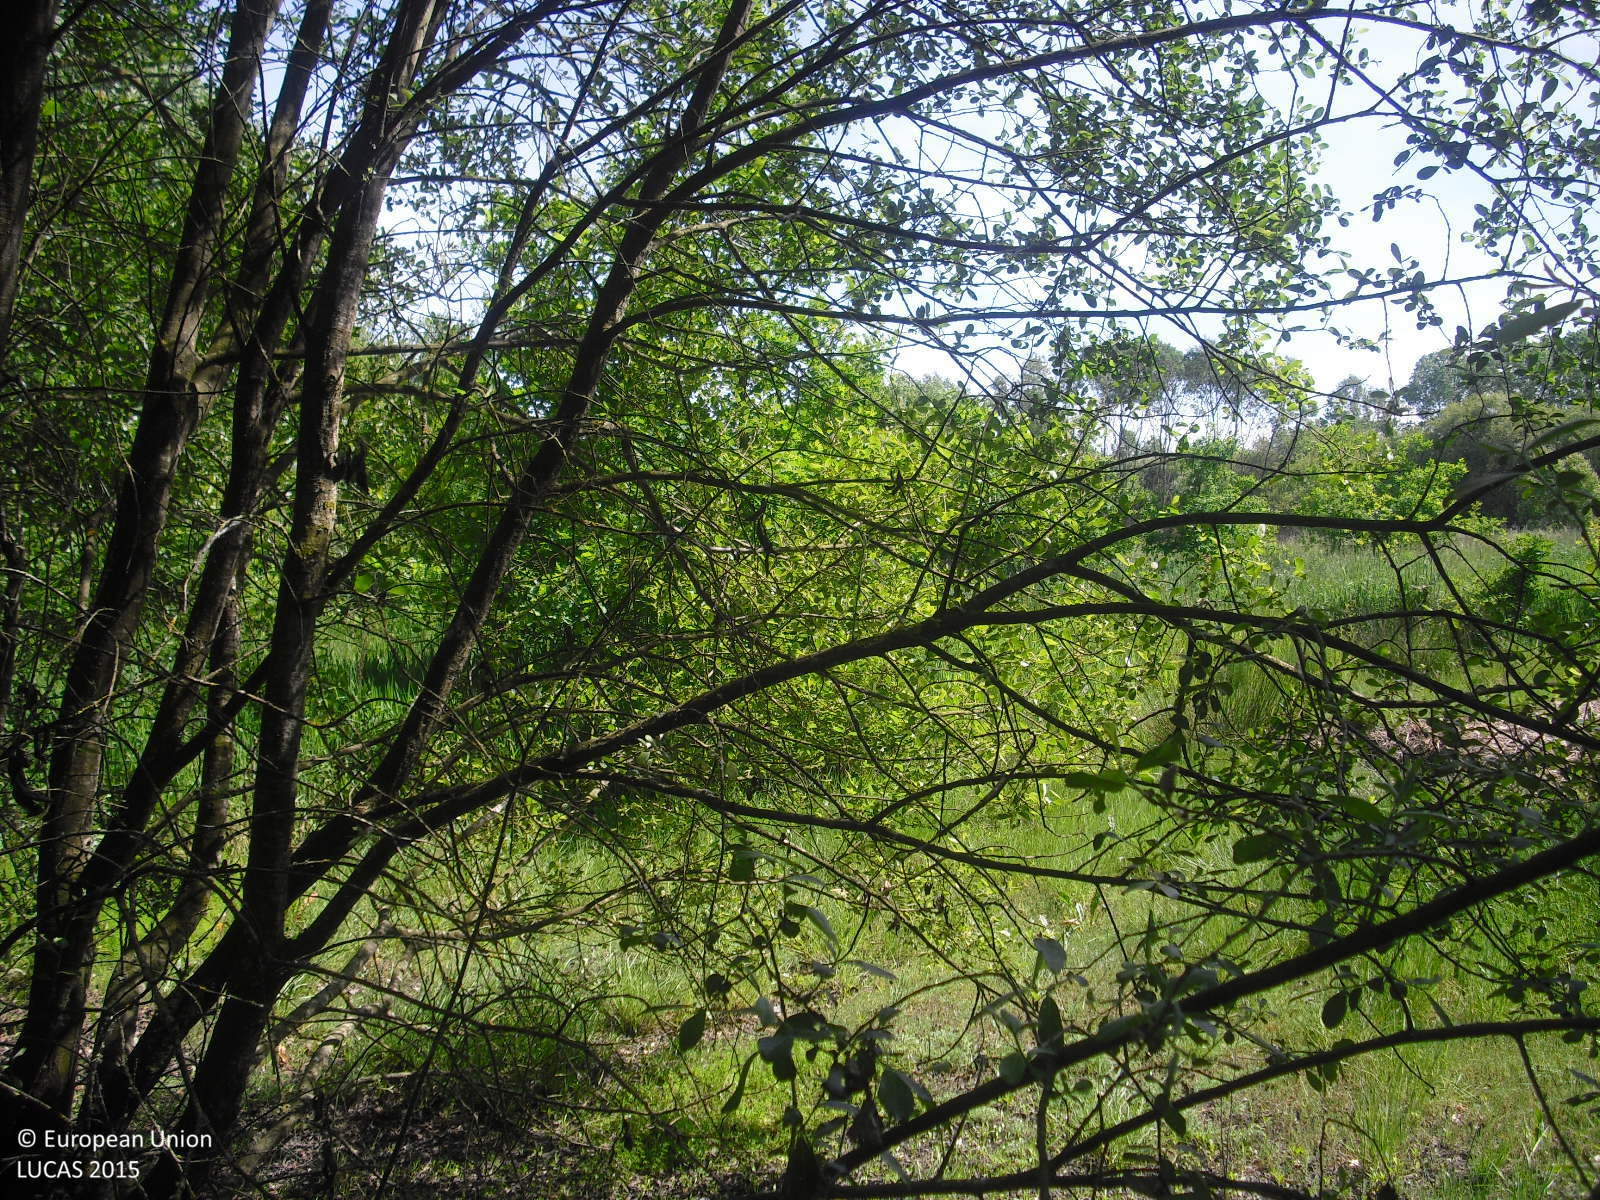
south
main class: Woodland
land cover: Broadleaved woodland
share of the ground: 50 - 75 %
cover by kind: broadleaved forest trees 70 %, herbaceous plants 20 %, shrubs 10 %
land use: Abandoned areas
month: May
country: ES
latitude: 42.0932
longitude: -7.7094
